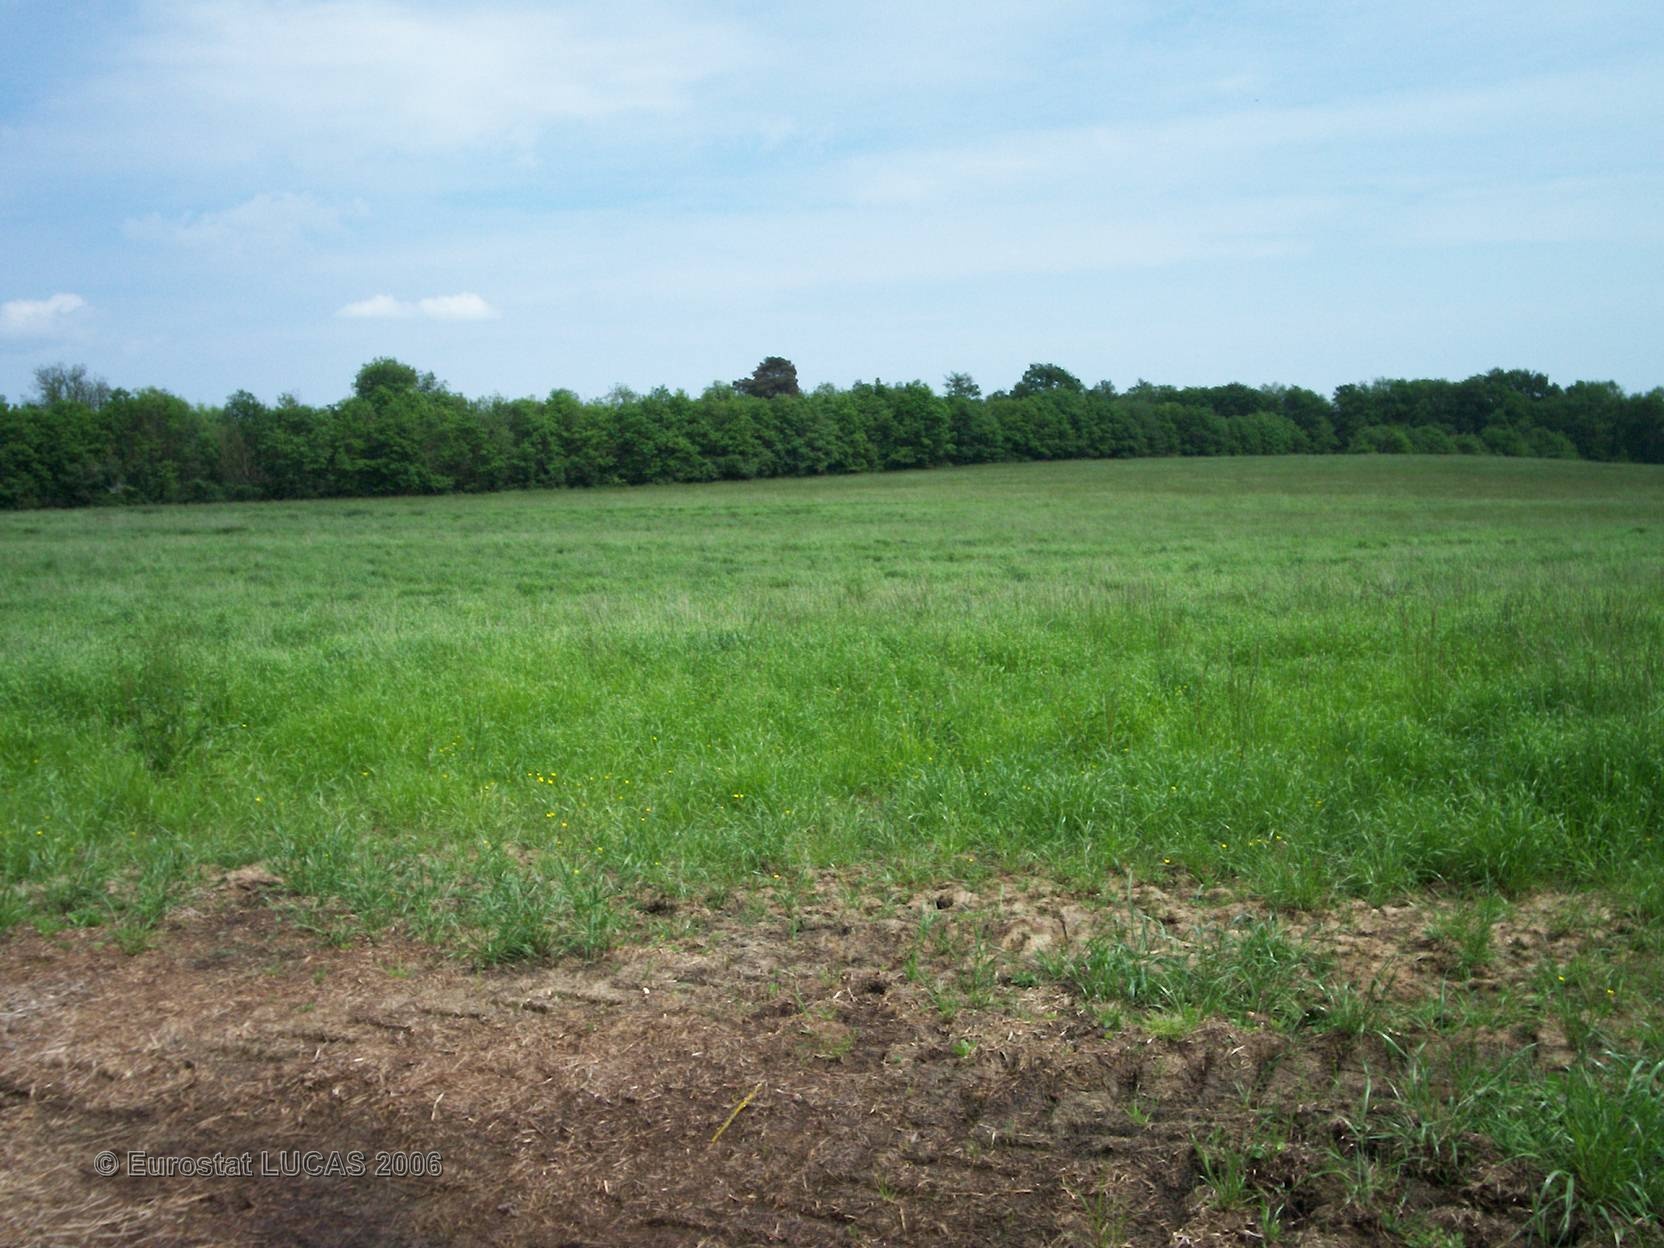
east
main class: Grassland
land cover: Grassland without tree/shrub cover
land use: Agriculture (excluding fallow land and kitchen gardens)
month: May
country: FR
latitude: 46.7517
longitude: 1.0184
